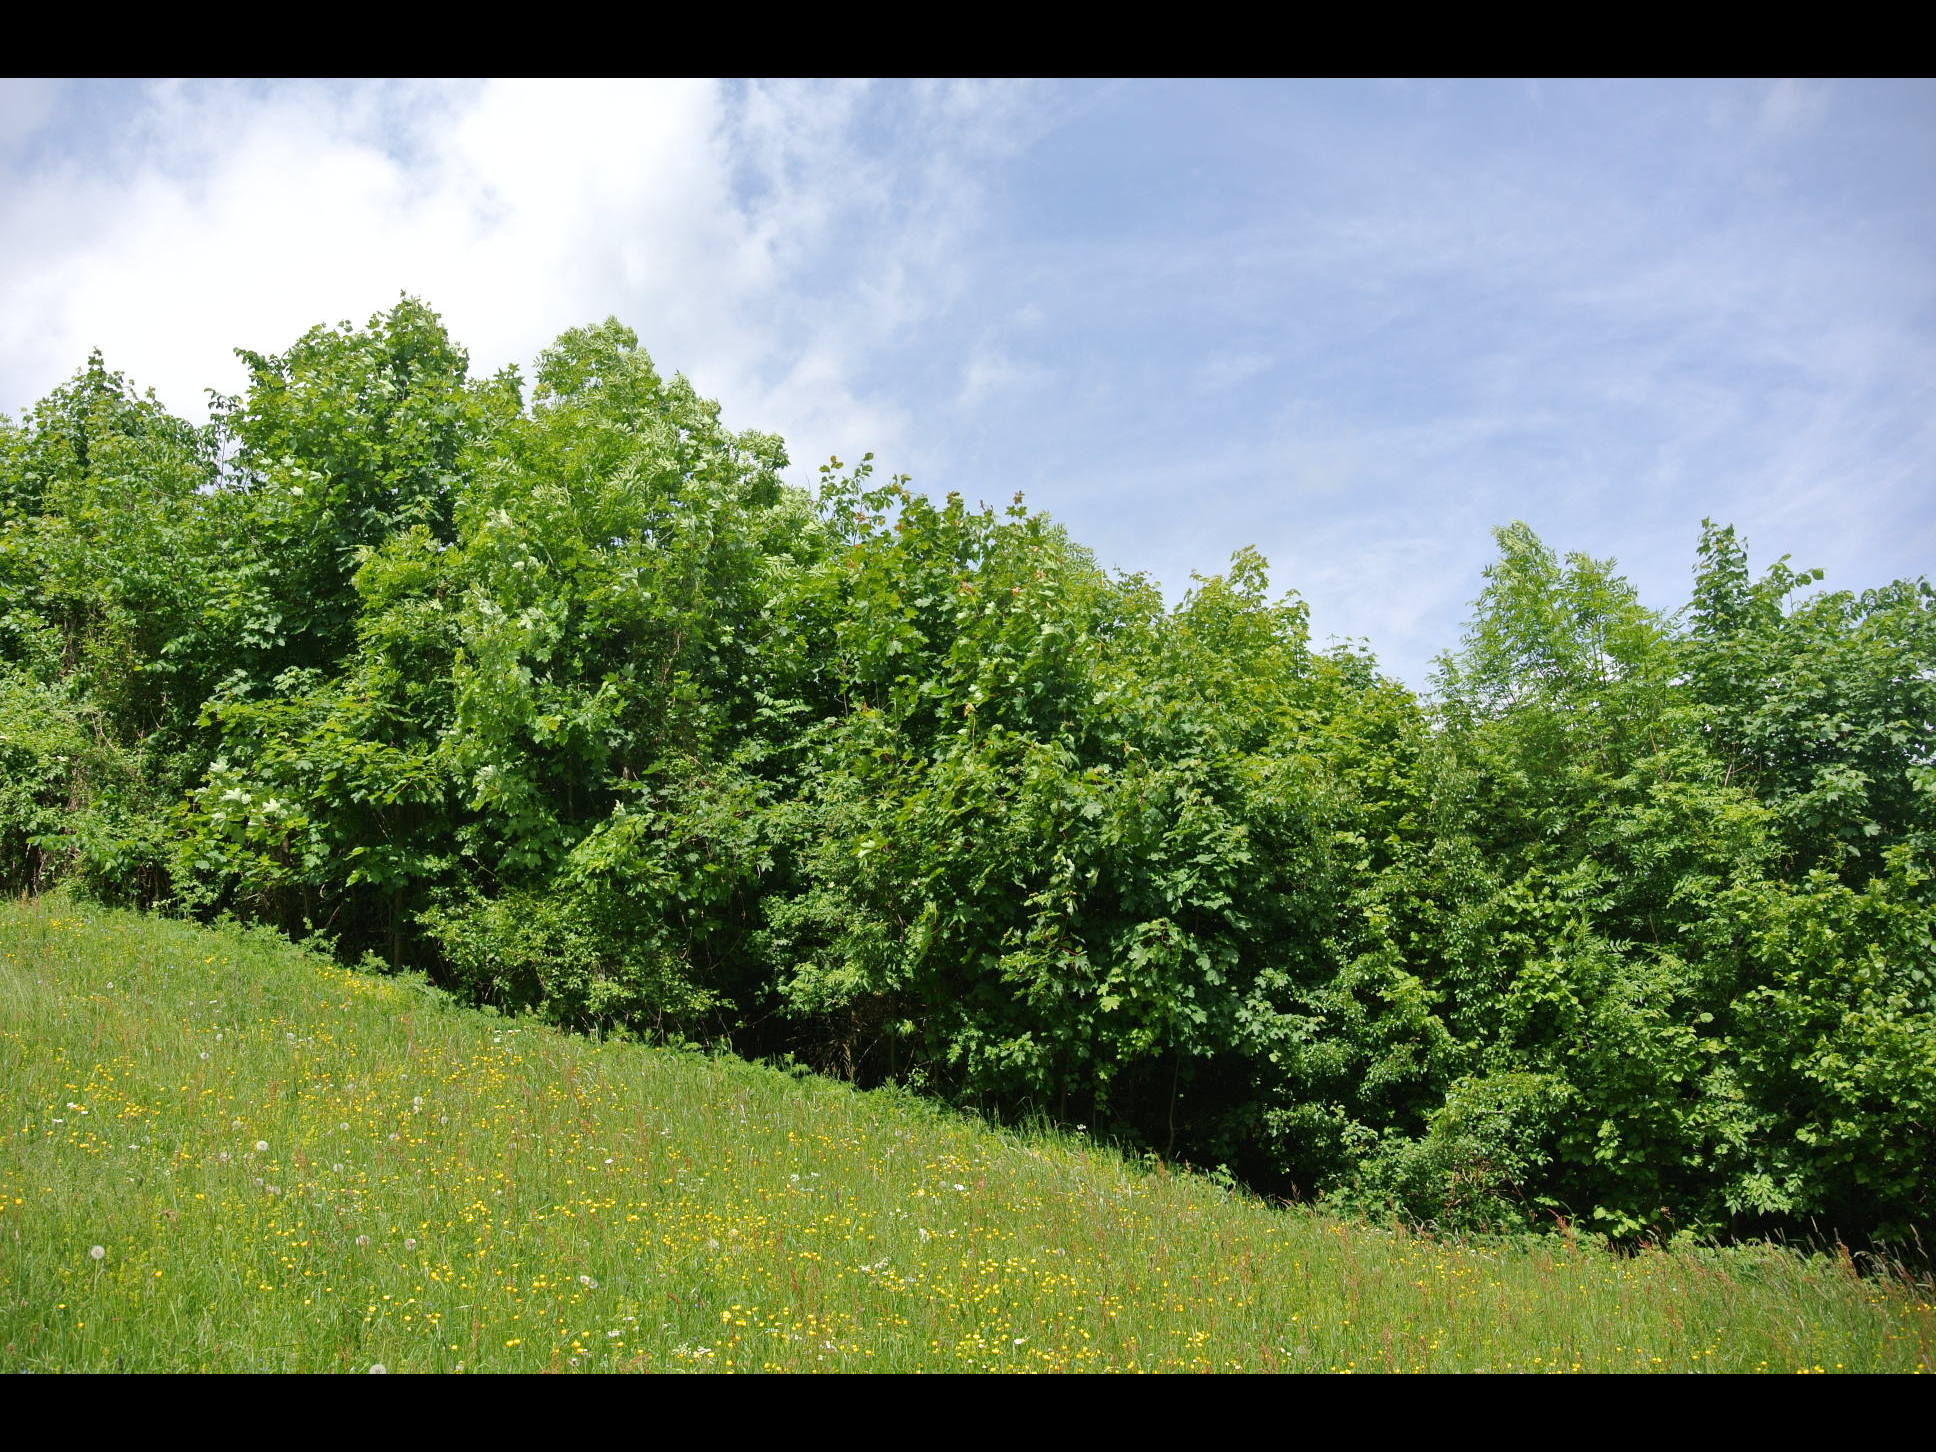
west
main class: Grassland
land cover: Grassland without tree/shrub cover
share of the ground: > 75 %
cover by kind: herbaceous plants 100 %
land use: Agriculture (excluding fallow land and kitchen gardens)
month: May
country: AT
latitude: 47.9998
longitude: 15.7792
